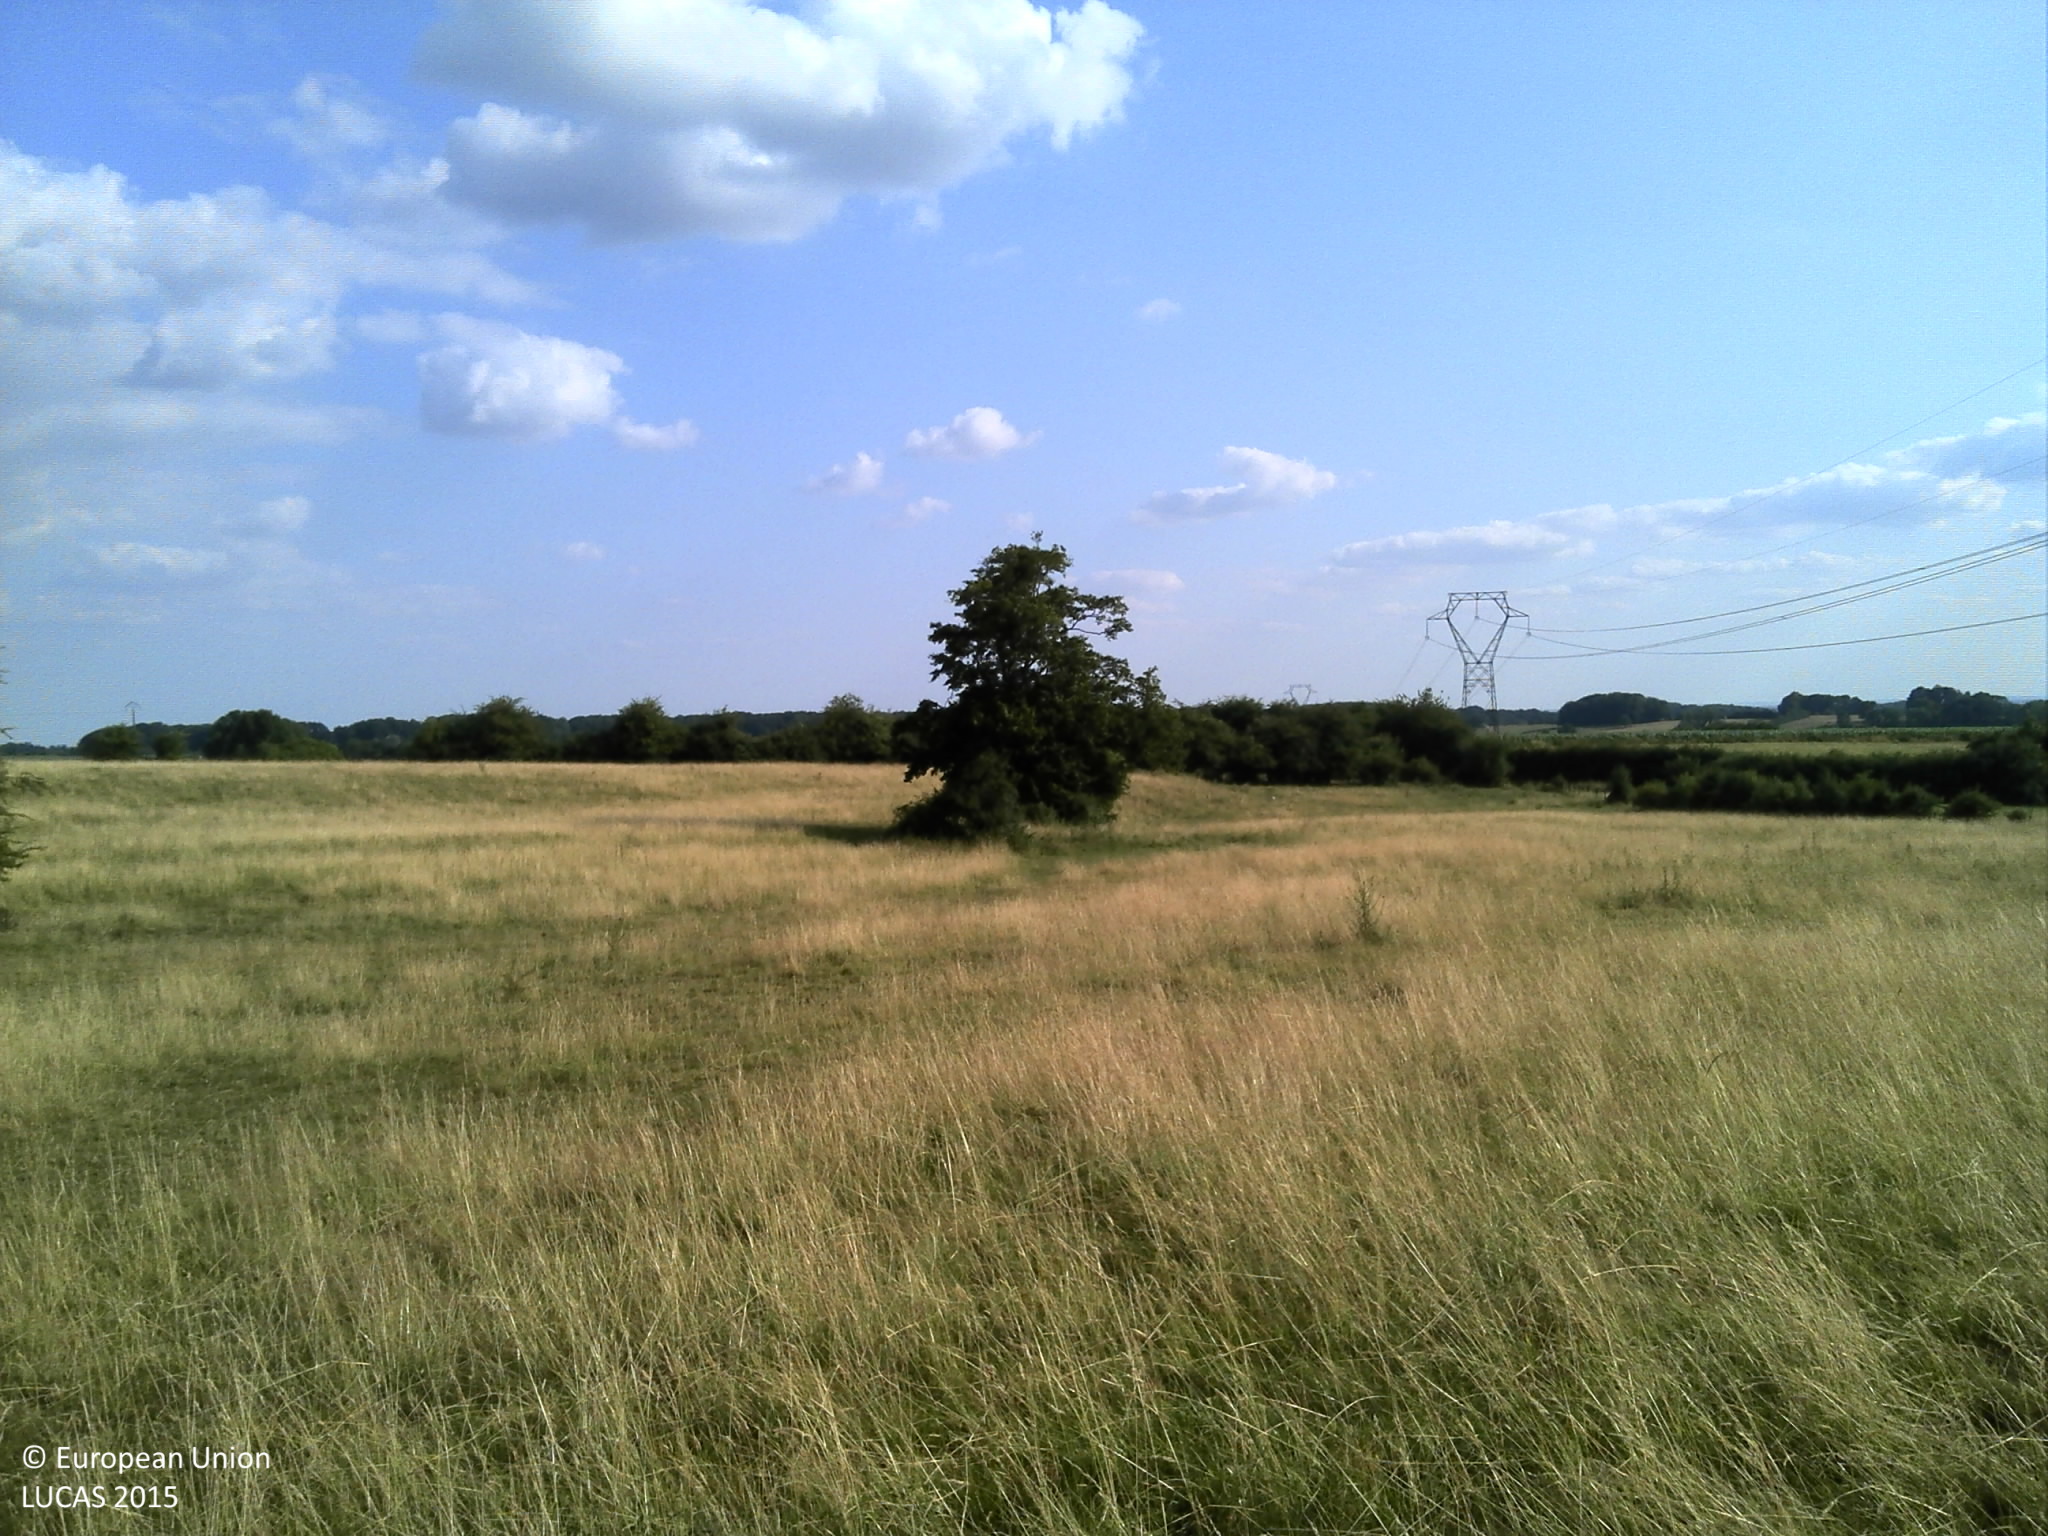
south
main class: Grassland
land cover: Grassland without tree/shrub cover
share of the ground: > 75 %
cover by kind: herbaceous plants 100 %
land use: Agriculture (excluding fallow land and kitchen gardens)
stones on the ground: < 10 %
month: July
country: FR
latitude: 49.6369
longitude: 4.4990
